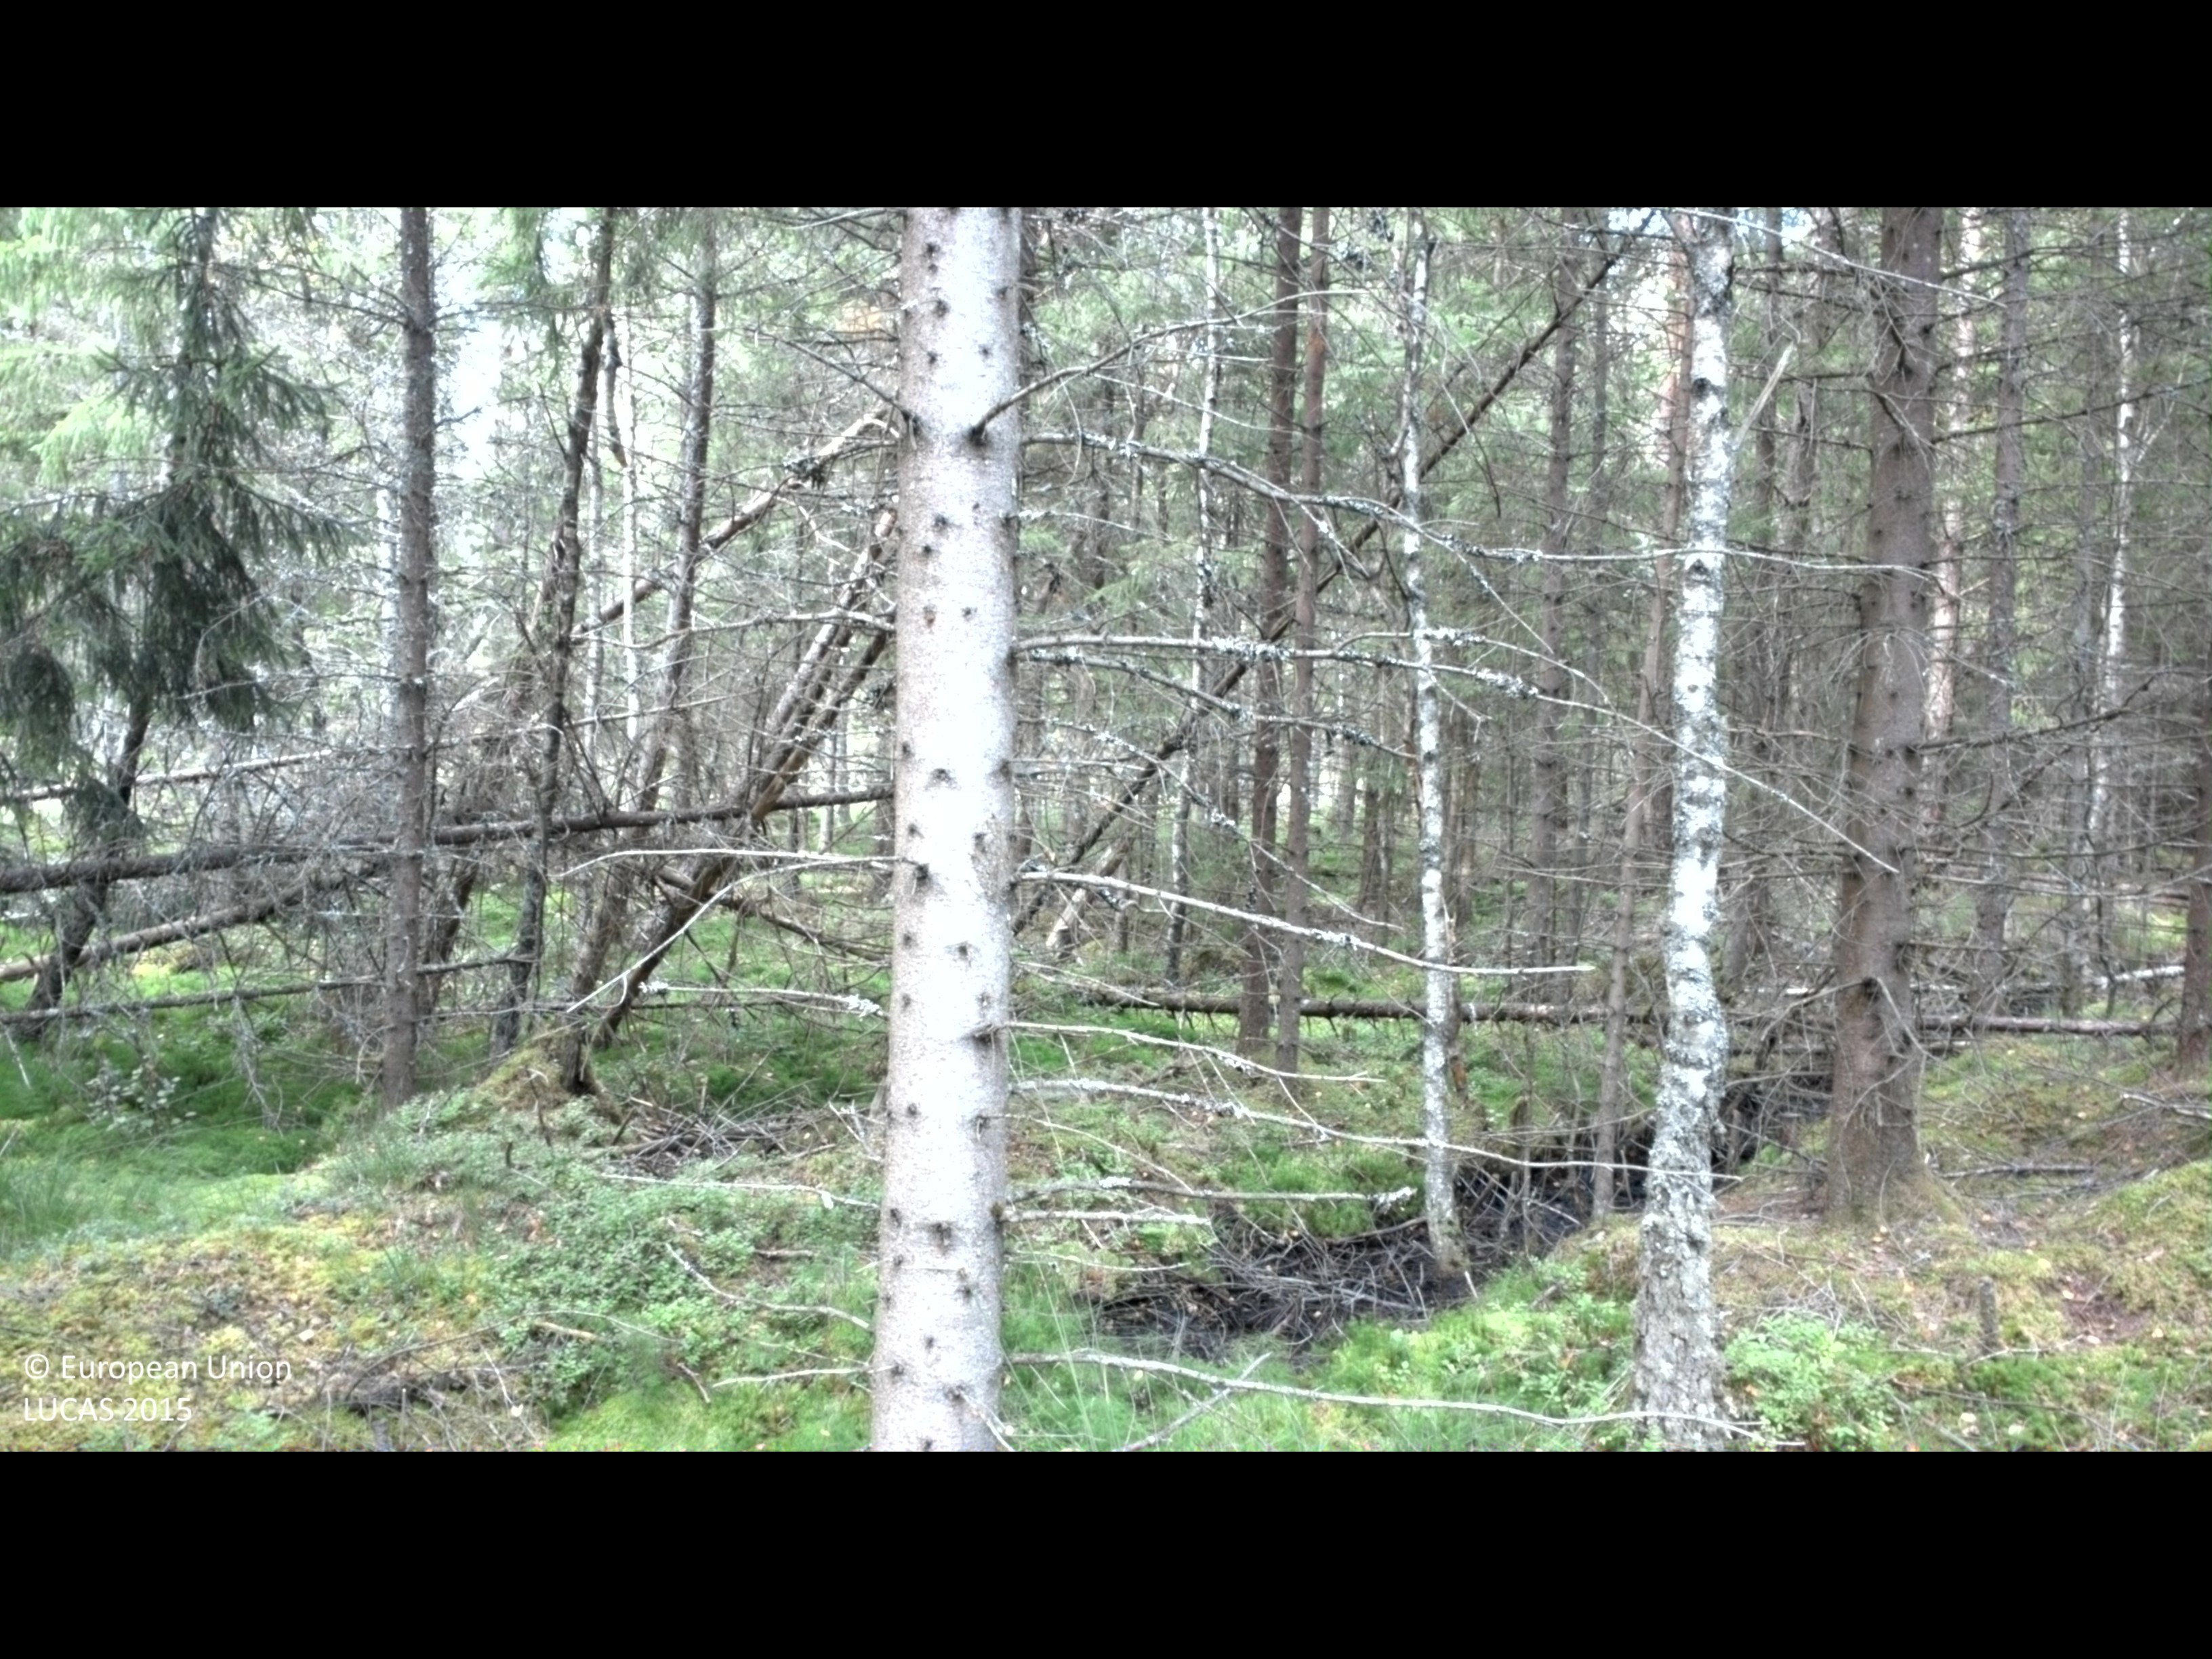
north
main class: Woodland
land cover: Spruce dominated coniferous woodland
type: boreal forest
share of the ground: 50 - 75 %
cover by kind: coniferous forest trees 60 %, shrubs 20 %, broadleaved forest trees 15 %, herbaceous plants 5 %
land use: Forestry
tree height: > 5 m
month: August
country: SE
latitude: 57.1731
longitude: 13.8828
